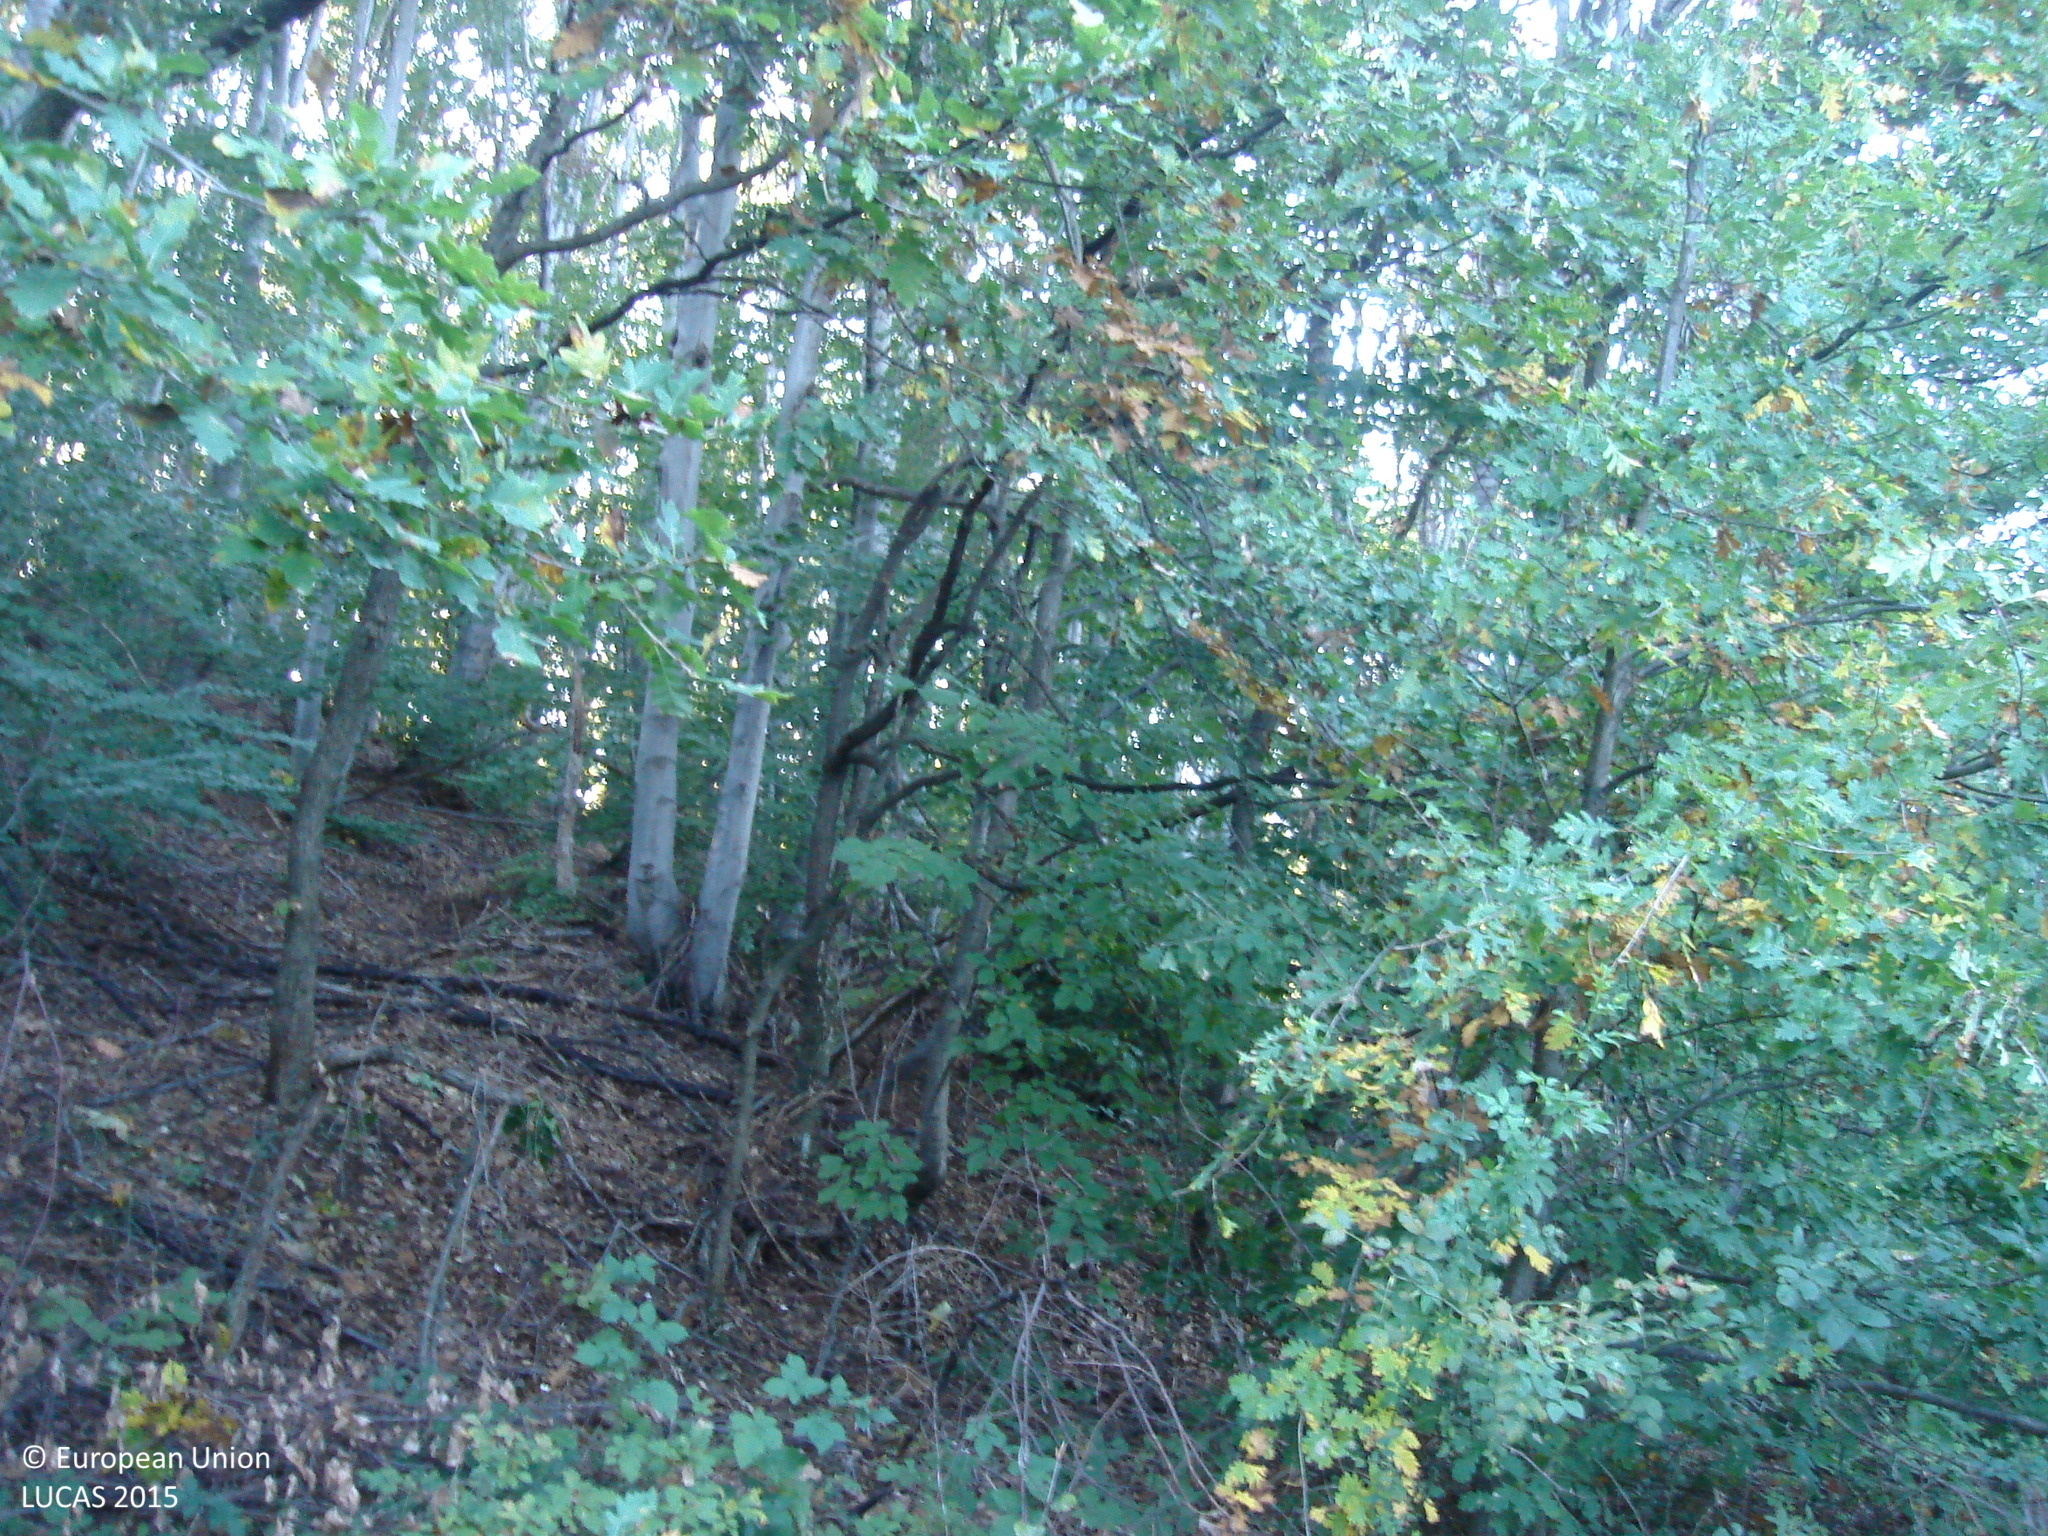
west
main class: Woodland
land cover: Broadleaved woodland
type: mesophytic deciduous forest
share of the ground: 50 - 75 %
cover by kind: broadleaved forest trees 60 %, herbaceous plants 20 %, unconsolidated bare surface 20 %
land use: Forestry
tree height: > 5 m
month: October
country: BG
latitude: 42.5131
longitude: 23.9041
